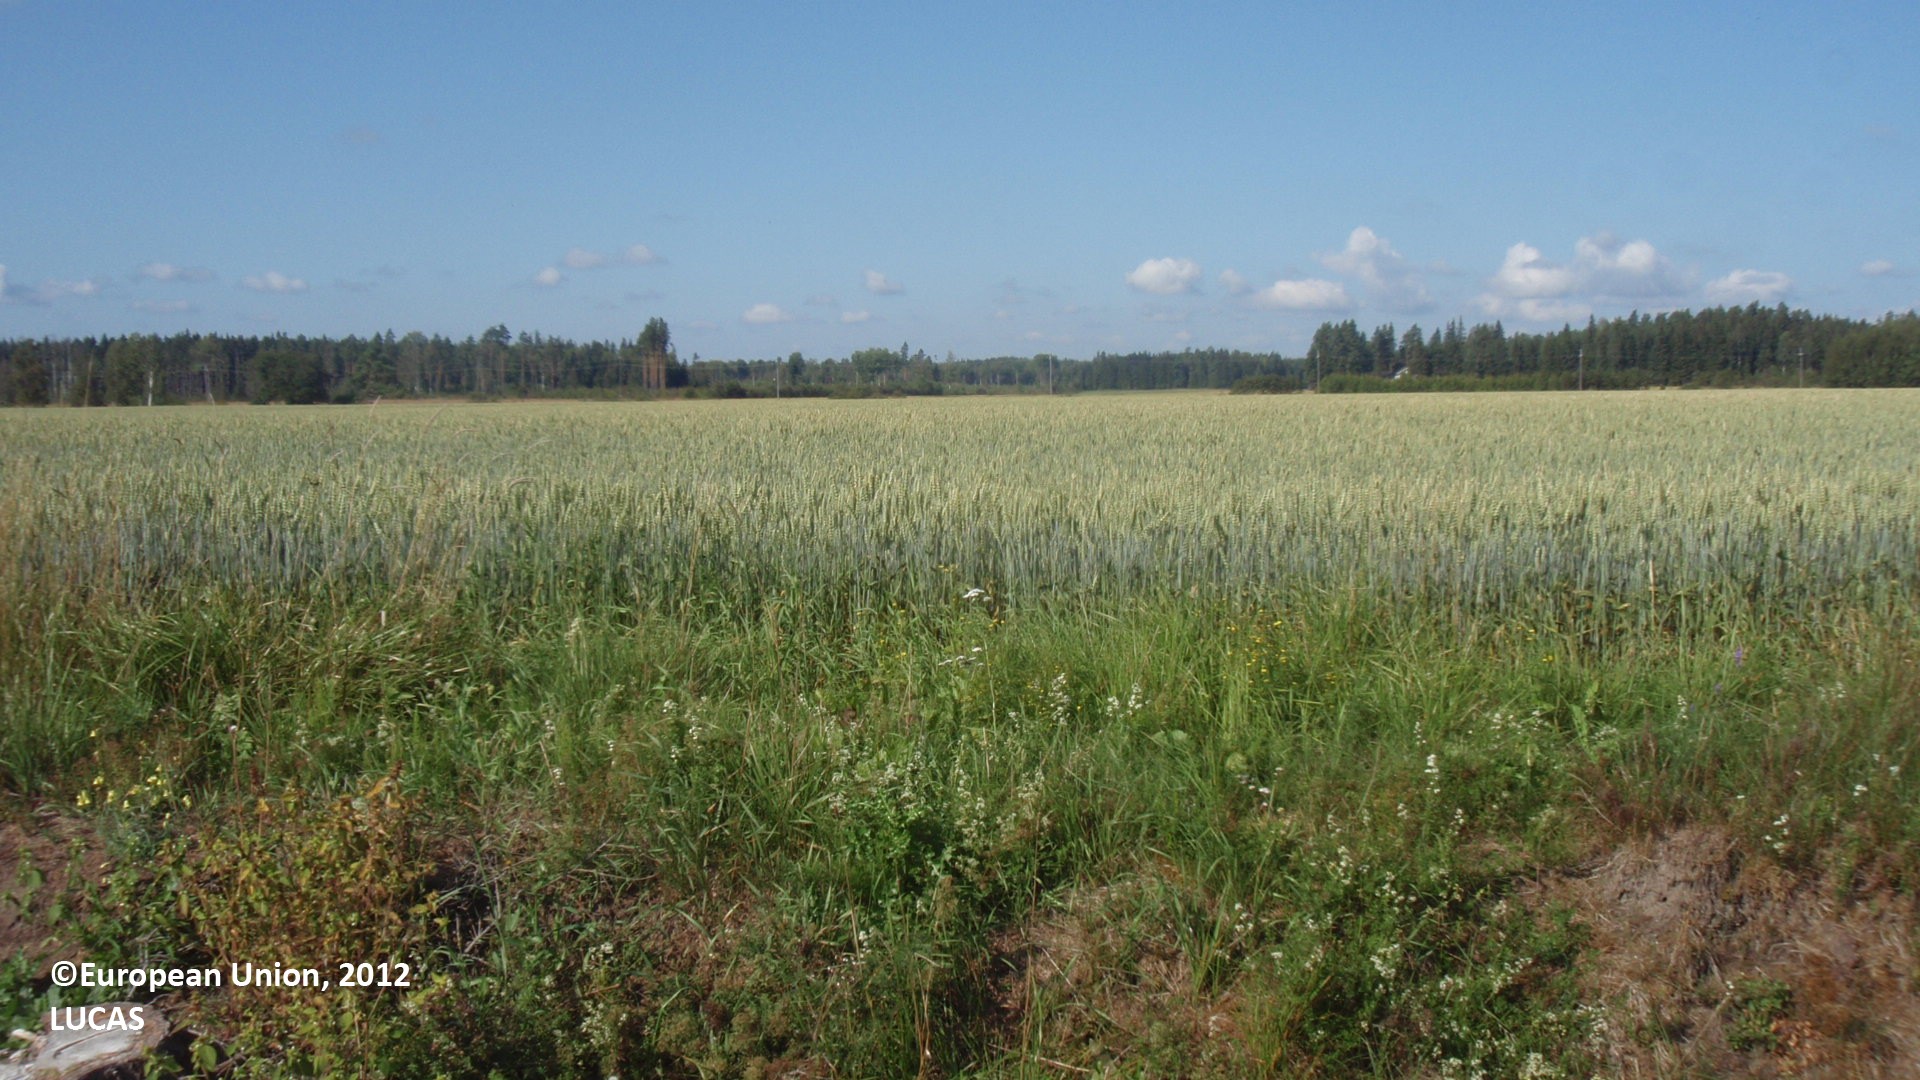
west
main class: Shrubland
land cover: Shrubland with sparse tree cover
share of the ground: > 75 %
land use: Agriculture (excluding fallow land and kitchen gardens)
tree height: < 5 m
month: August
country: FI
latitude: 60.7587
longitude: 26.7324
